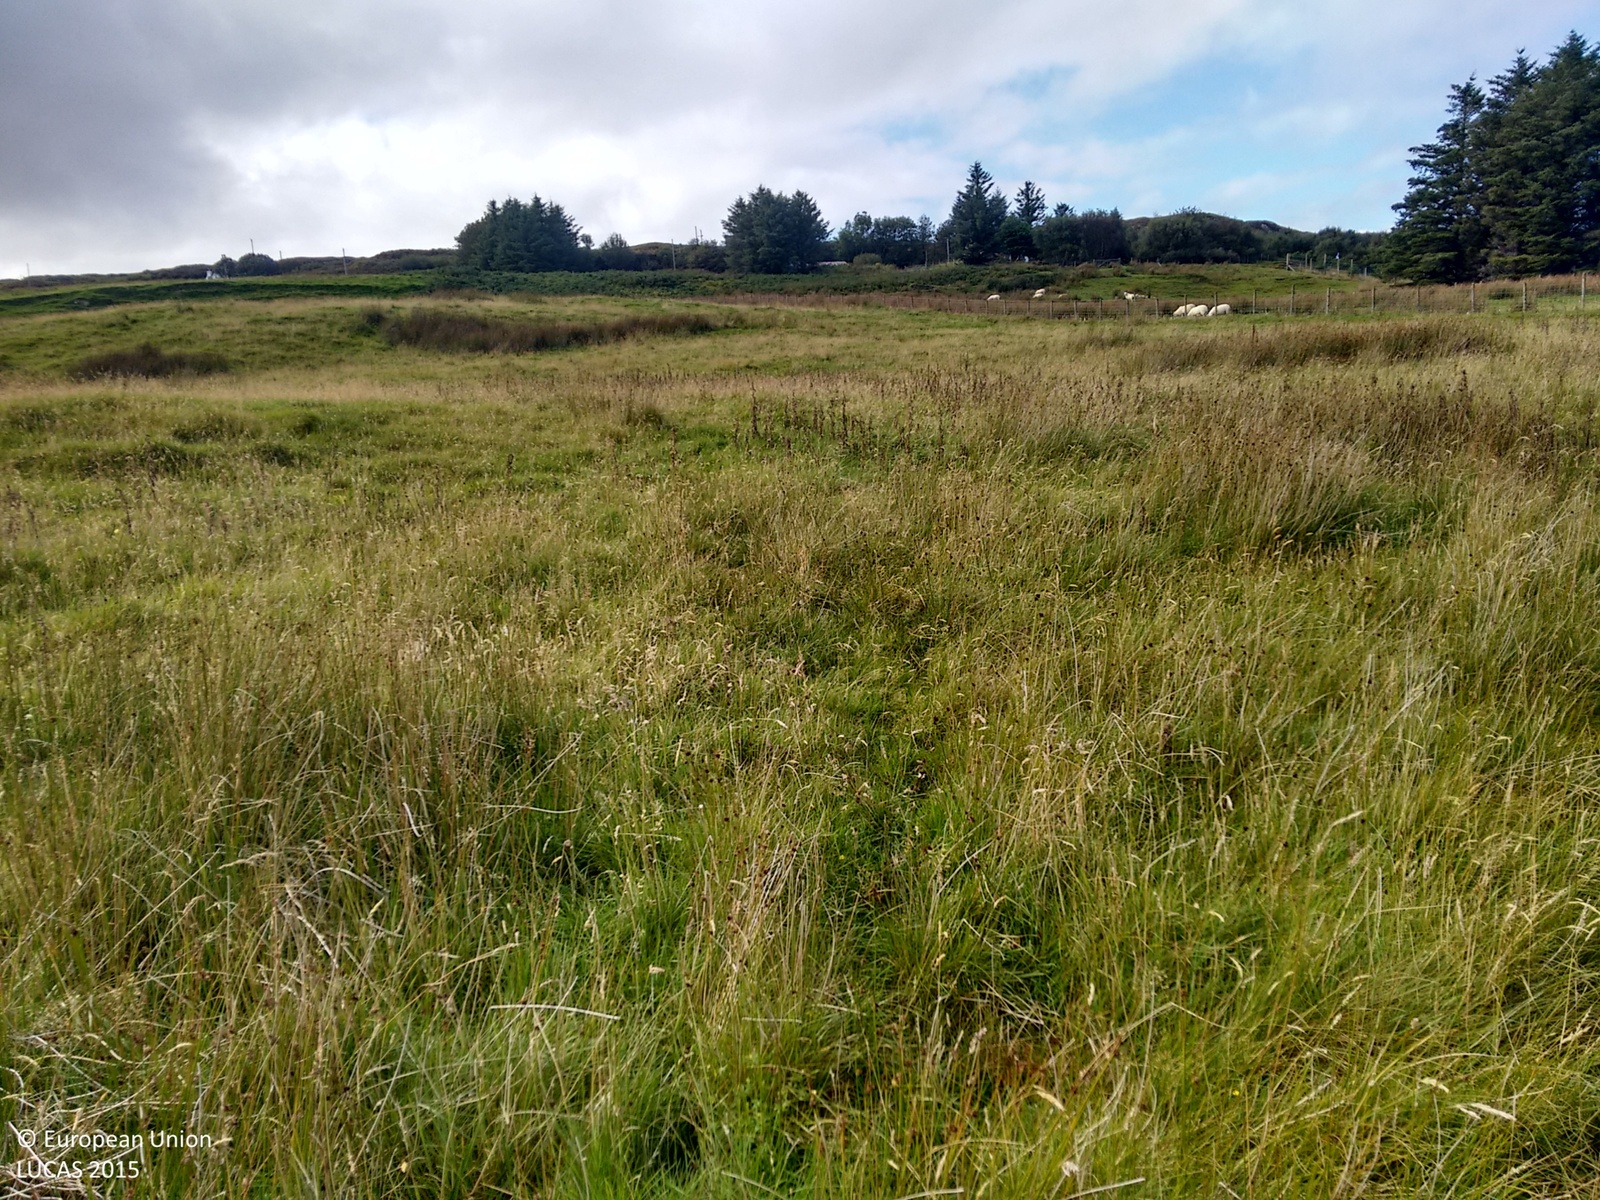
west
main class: Grassland
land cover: Grassland without tree/shrub cover
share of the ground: > 75 %
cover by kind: herbaceous plants 100 %
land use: Agriculture (excluding fallow land and kitchen gardens)
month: September
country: GB
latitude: 57.4404
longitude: -6.6921
